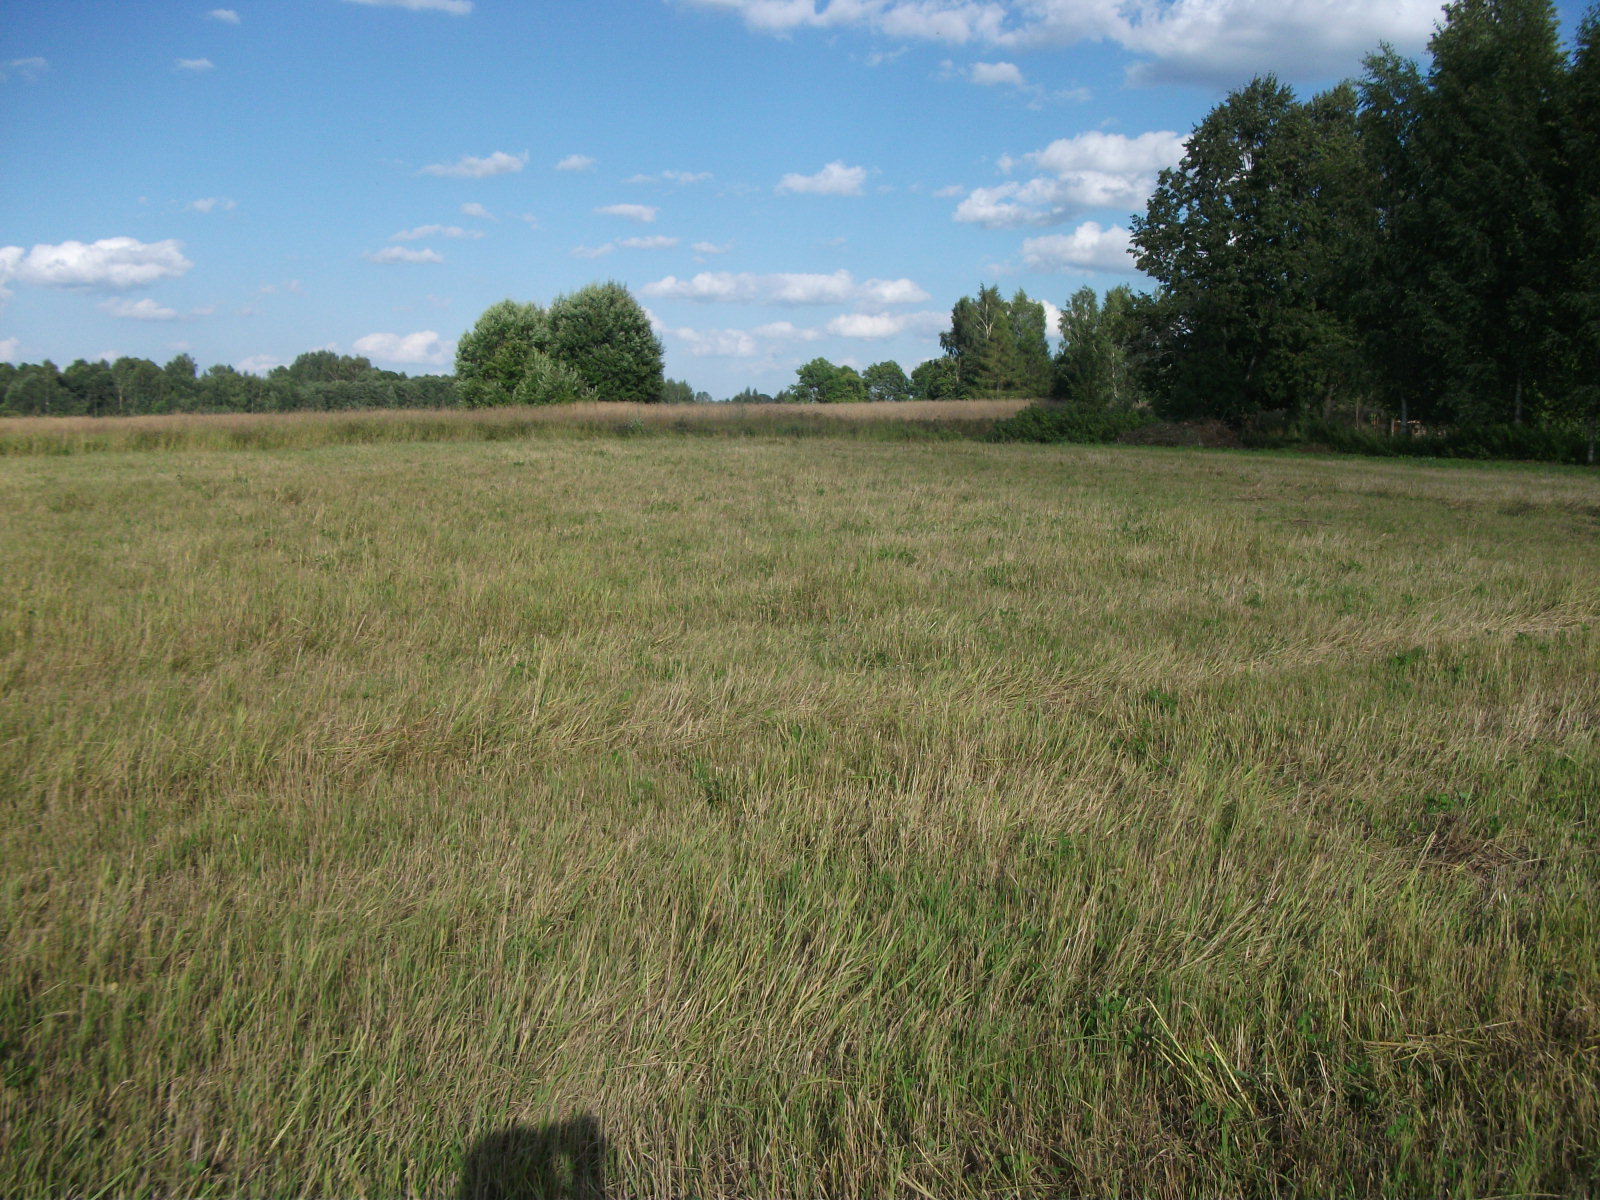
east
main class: Grassland
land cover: Grassland without tree/shrub cover
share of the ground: > 75 %
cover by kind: herbaceous plants 100 %
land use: Agriculture (excluding fallow land and kitchen gardens)
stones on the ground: < 10 %
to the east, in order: Grassland without tree/shrub cover
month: August
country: LV
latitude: 57.0316
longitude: 26.5746
